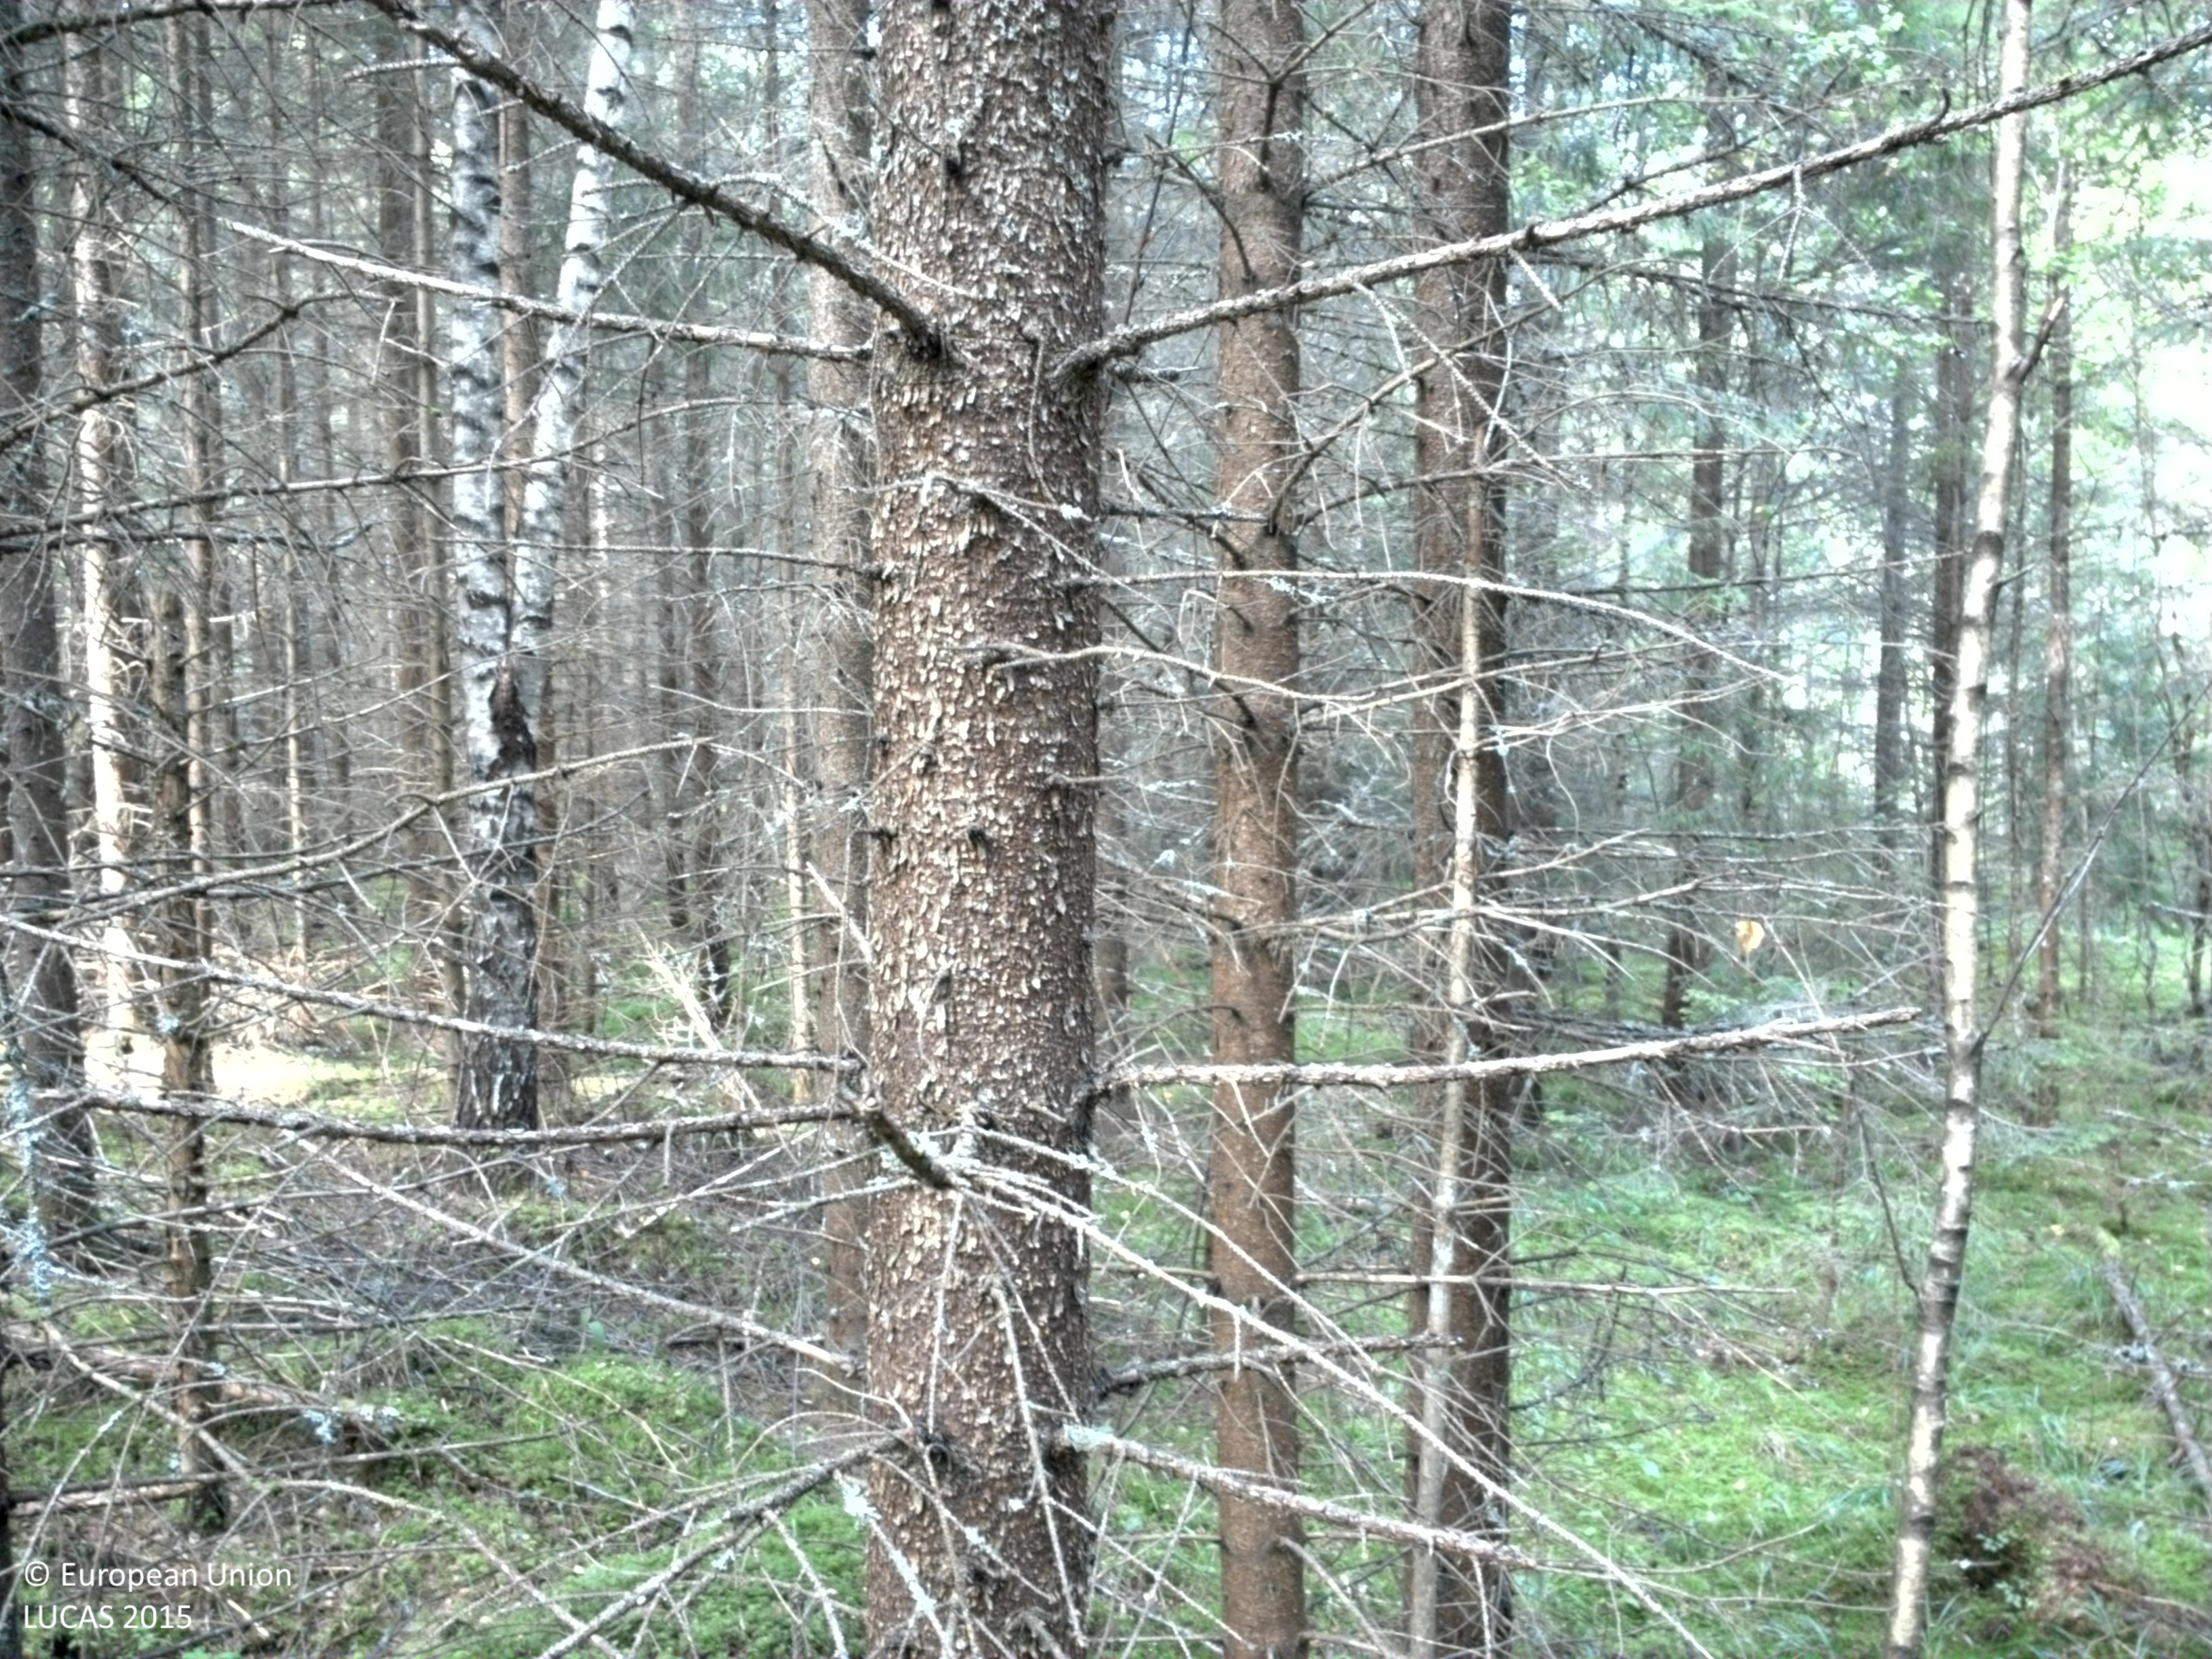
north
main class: Woodland
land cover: Spruce dominated coniferous woodland
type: boreal forest
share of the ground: > 75 %
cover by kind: coniferous forest trees 95 %, lichens and mosses 5 %
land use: Forestry
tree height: > 5 m
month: August
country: SE
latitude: 59.9606
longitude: 16.4557
